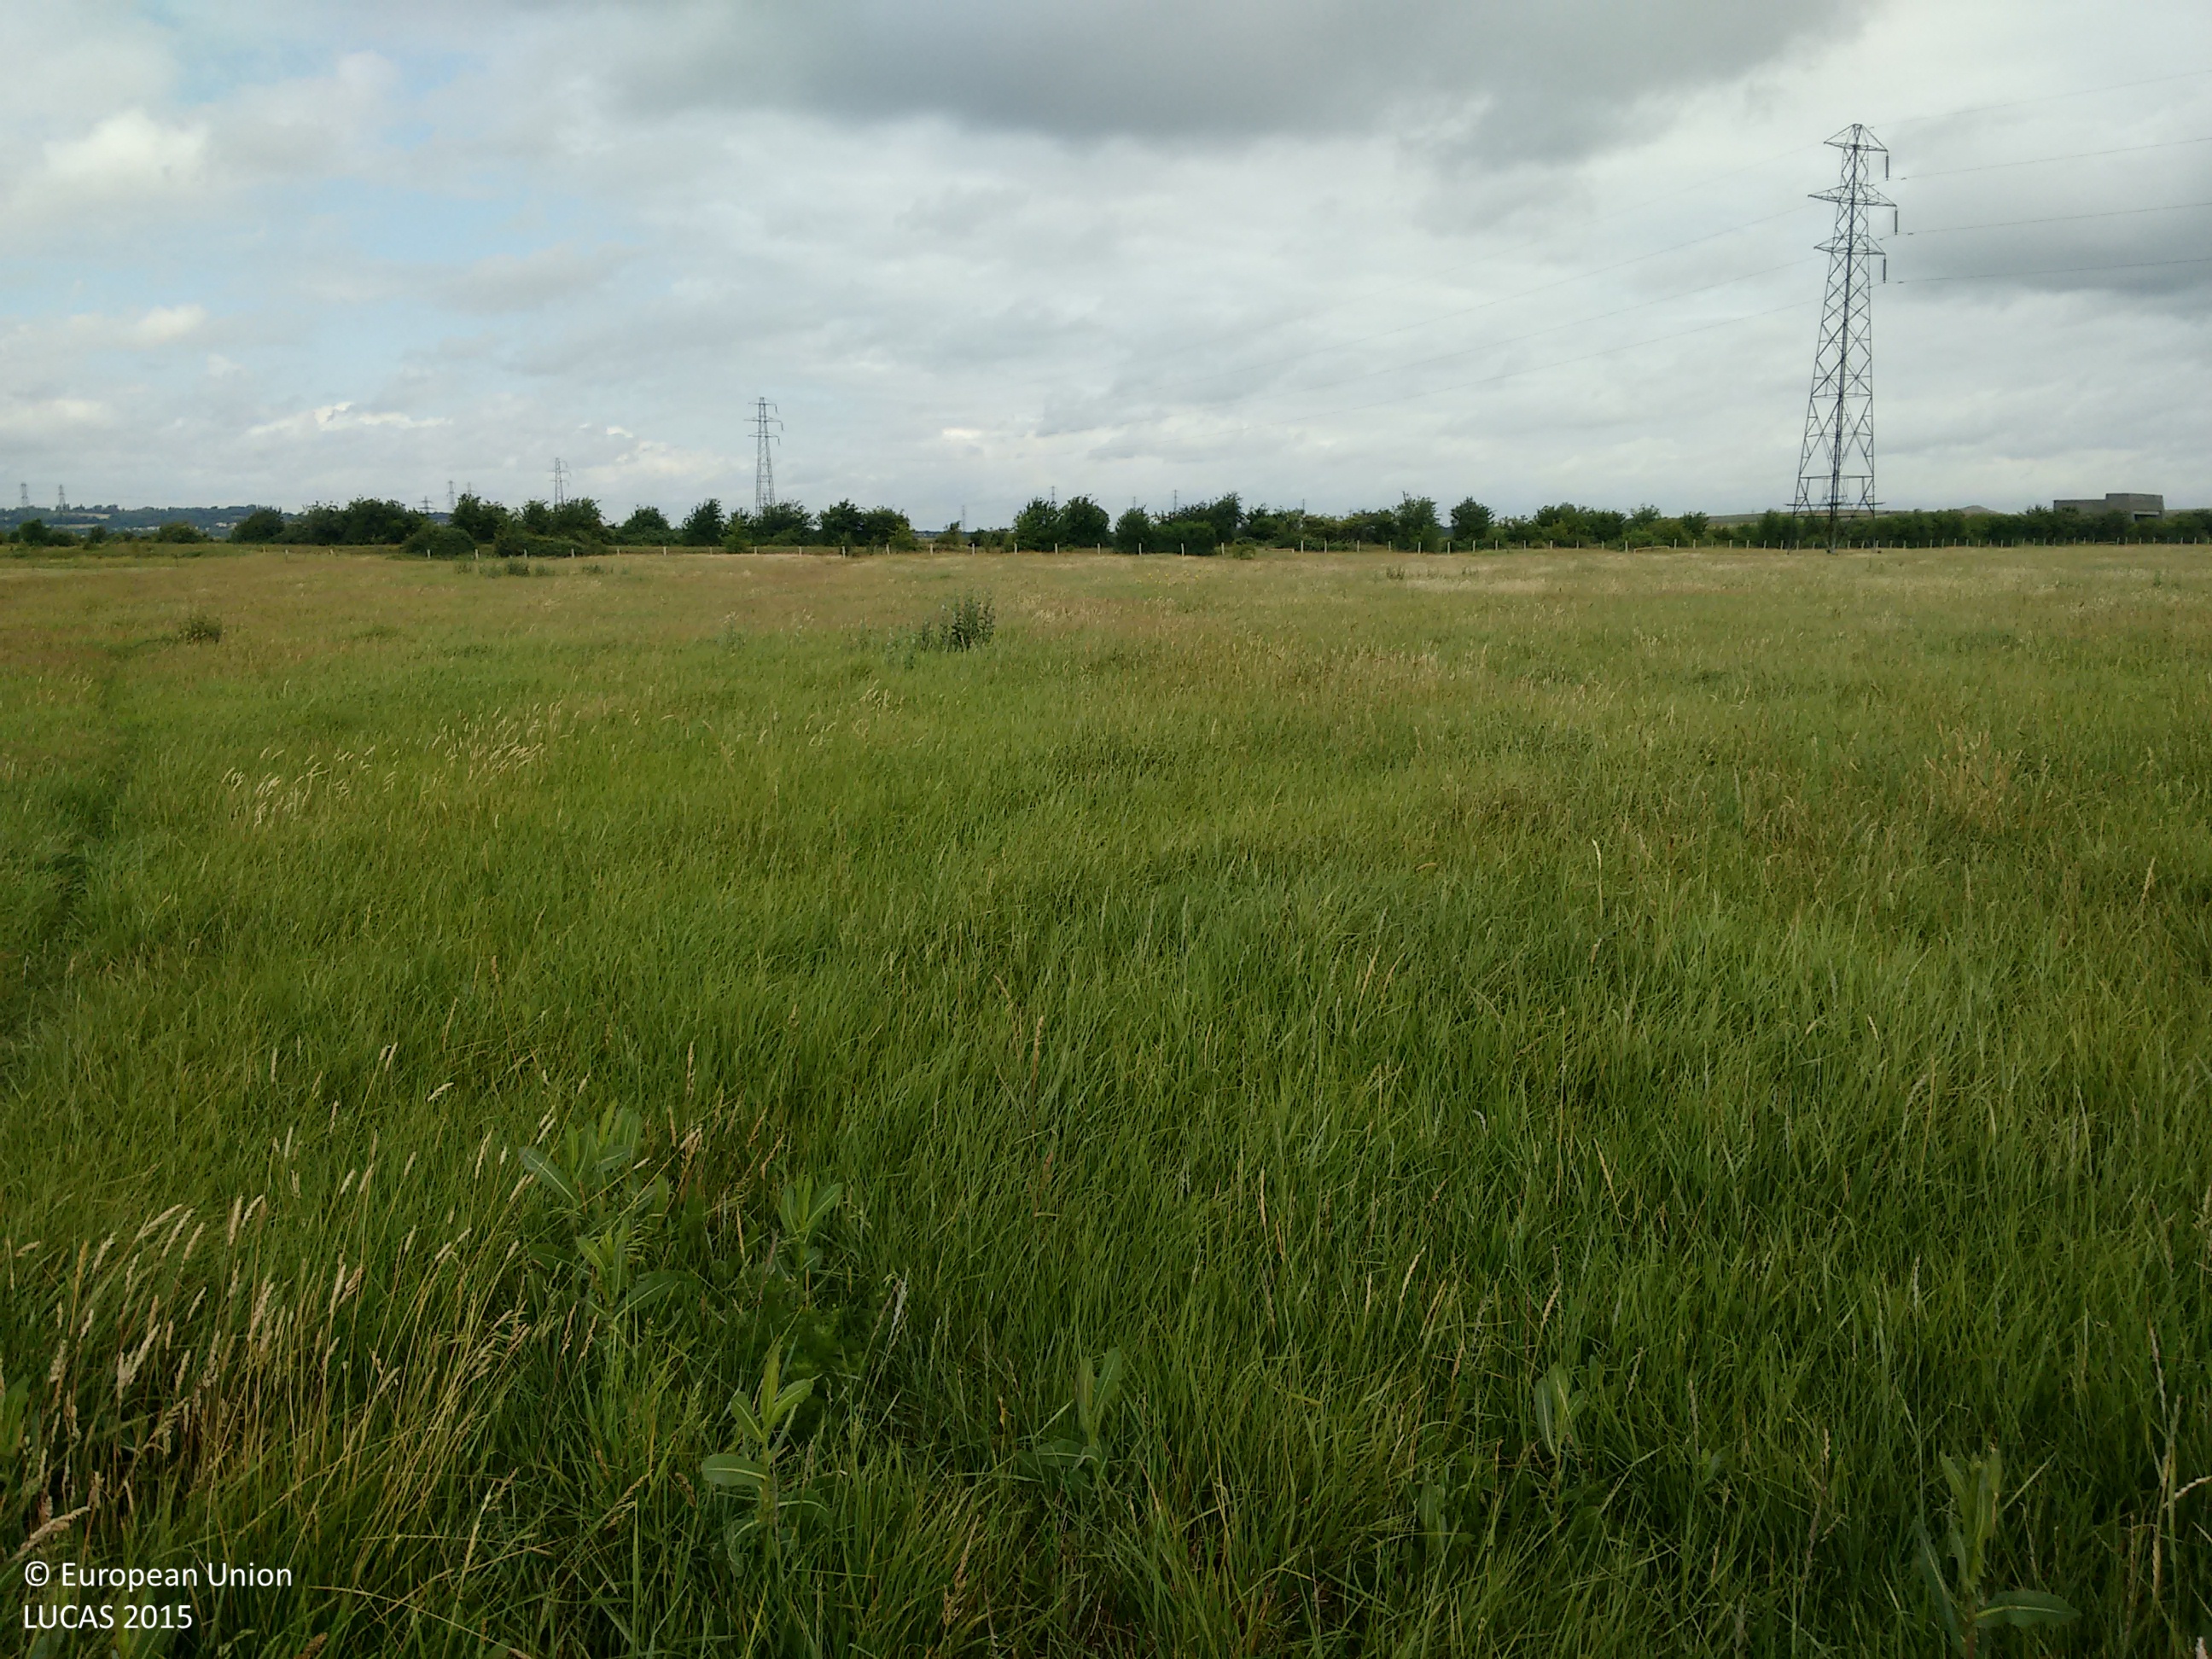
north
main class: Grassland
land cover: Grassland without tree/shrub cover
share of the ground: > 75 %
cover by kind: herbaceous plants 100 %
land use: Agriculture (excluding fallow land and kitchen gardens)
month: July
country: GB
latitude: 51.5252
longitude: 0.5025
